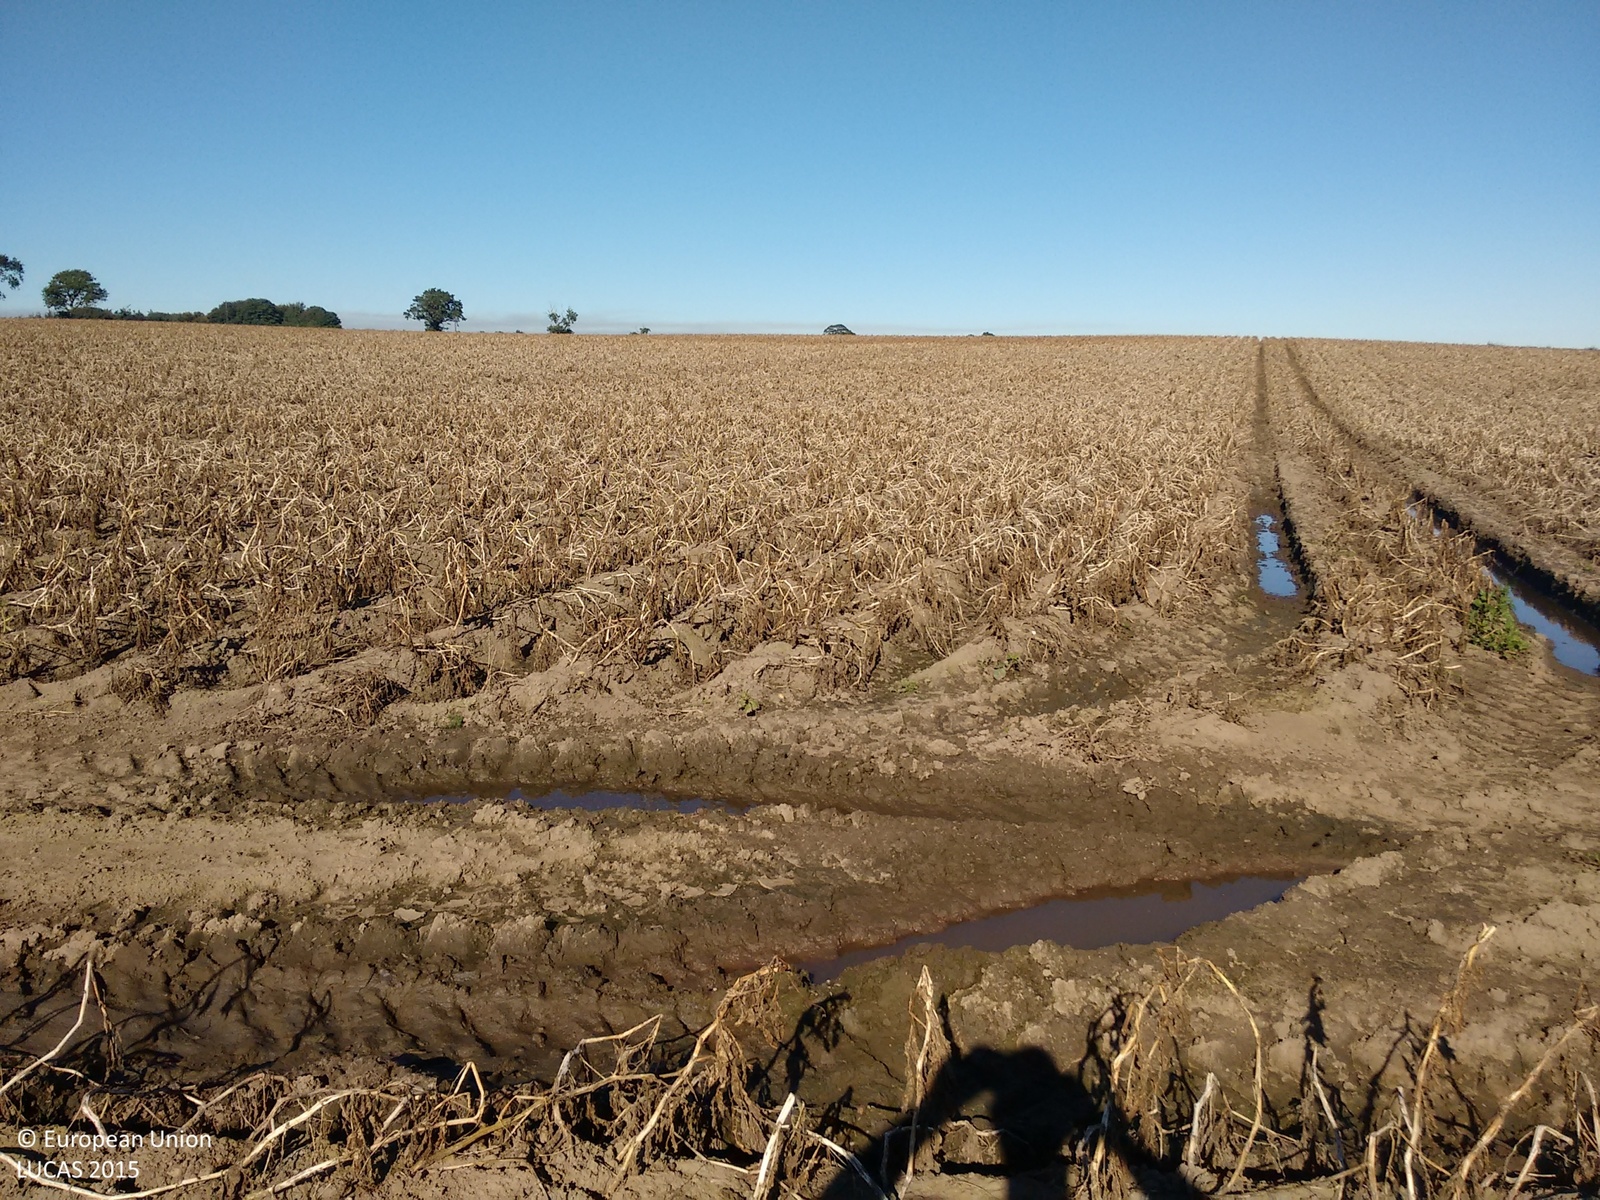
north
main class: Cropland
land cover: Potatoes
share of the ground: > 75 %
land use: Agriculture (excluding fallow land and kitchen gardens)
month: October
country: GB
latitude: 56.6984
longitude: -2.5503
